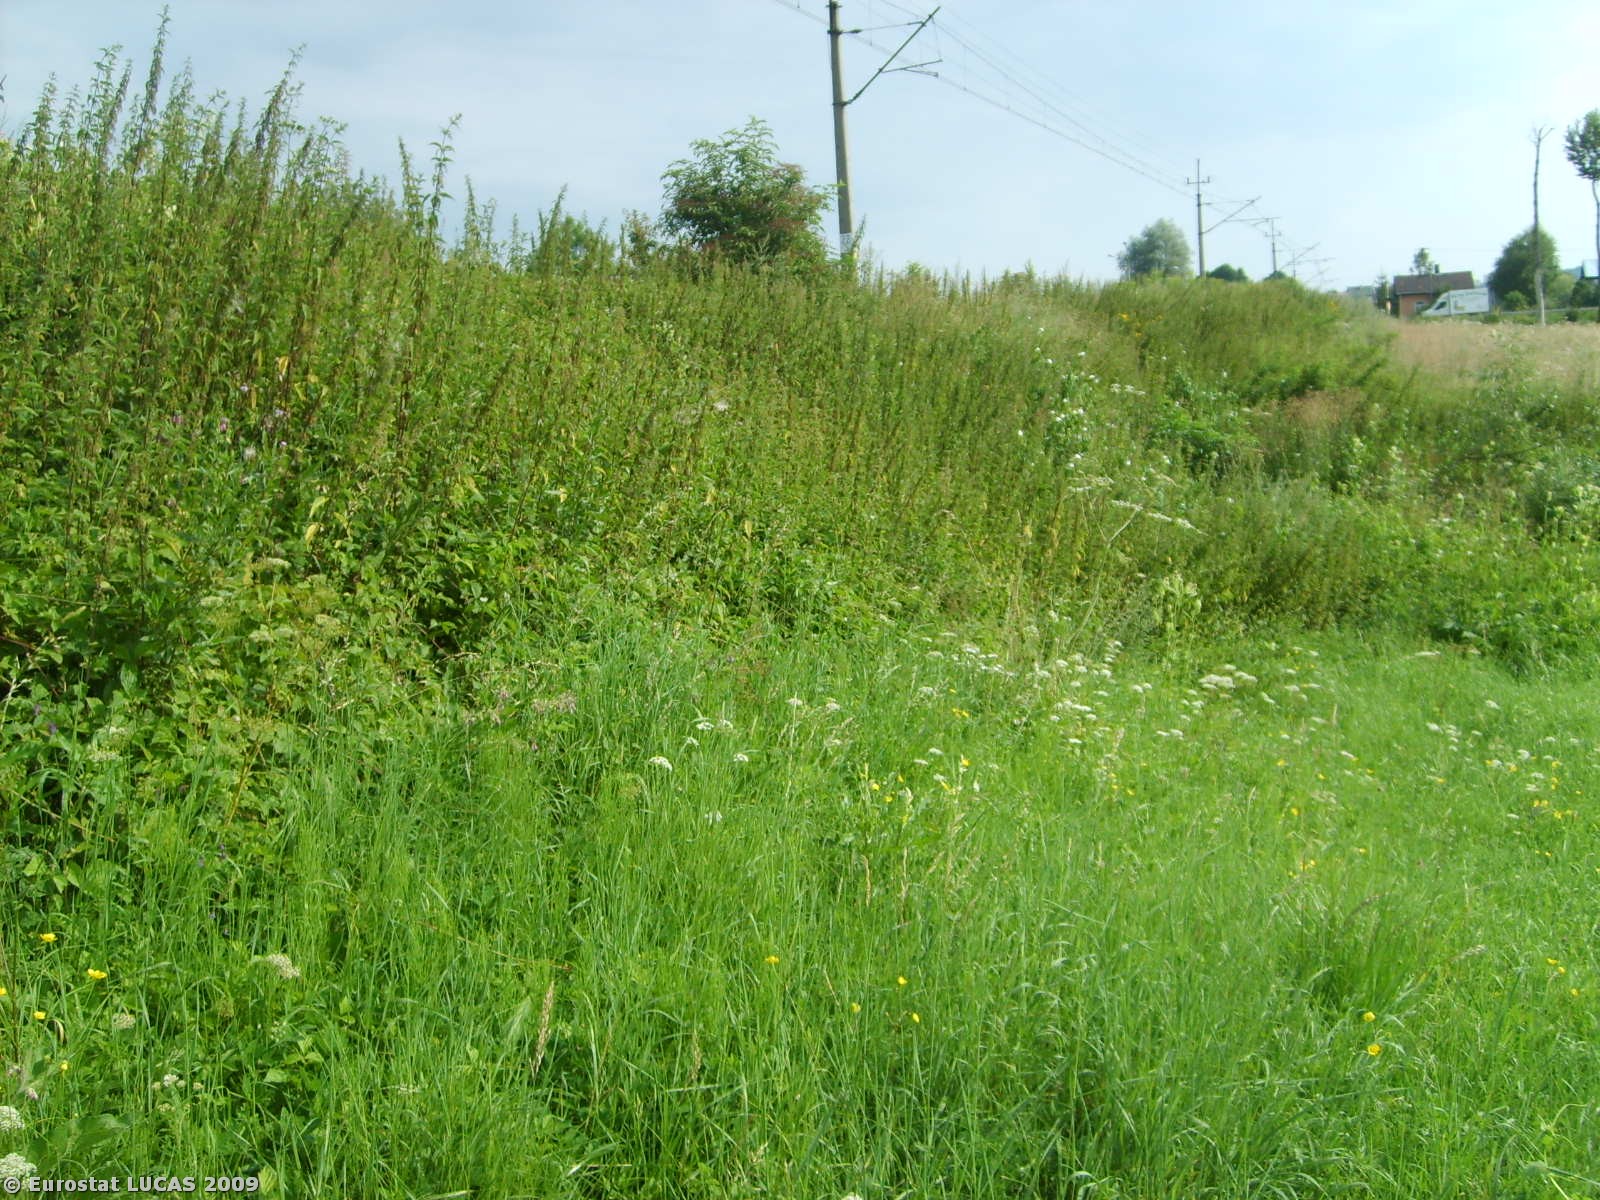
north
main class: Grassland
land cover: Grassland without tree/shrub cover
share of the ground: > 75 %
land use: Unused
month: July
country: PL
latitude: 49.8811
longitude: 21.0522
